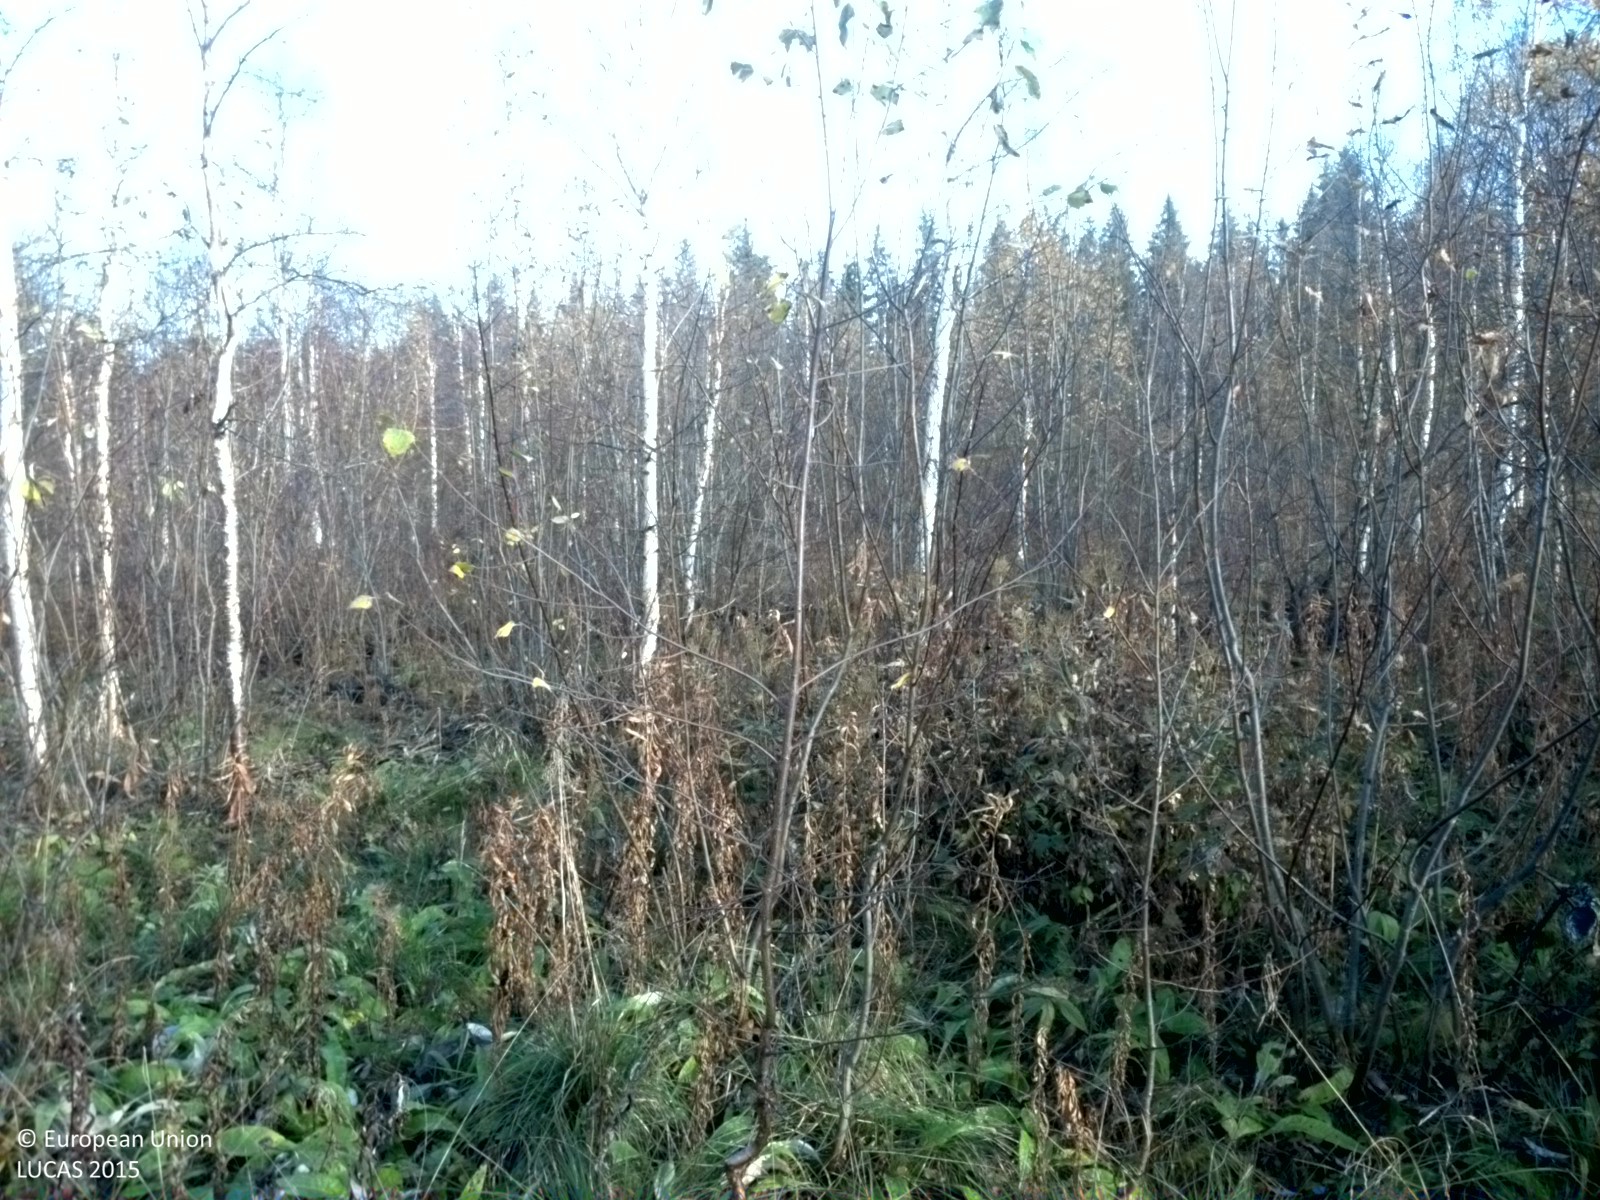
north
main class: Woodland
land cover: Broadleaved woodland
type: non-riverine alder, birch or aspen forest
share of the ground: 50 - 75 %
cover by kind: broadleaved forest trees 55 %, herbaceous plants 35 %, shrubs 10 %
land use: Forestry
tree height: > 5 m
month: October
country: SE
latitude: 65.7412
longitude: 21.4226
